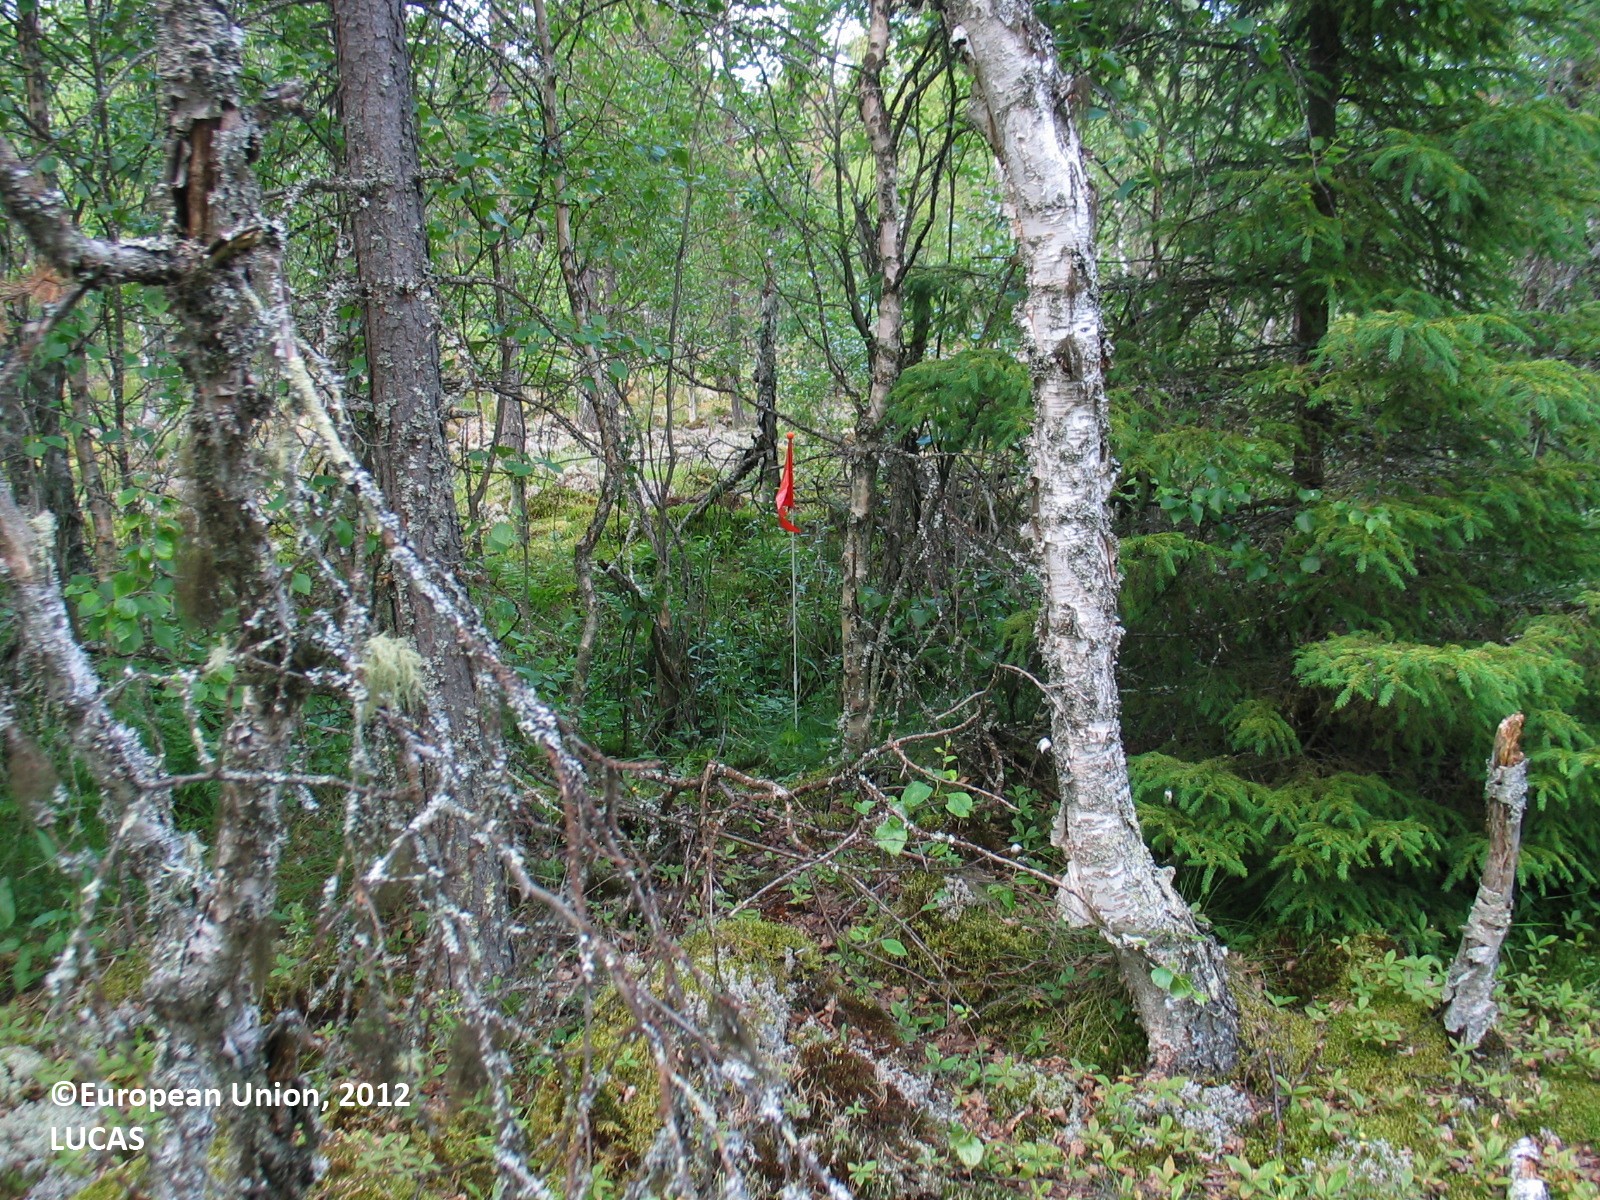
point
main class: Woodland
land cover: Other mixed woodland
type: boreal forest
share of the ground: 25 - 50 %
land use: Semi-natural and natural areas not in use
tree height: > 5 m
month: July
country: FI
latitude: 64.5294
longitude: 26.4736
